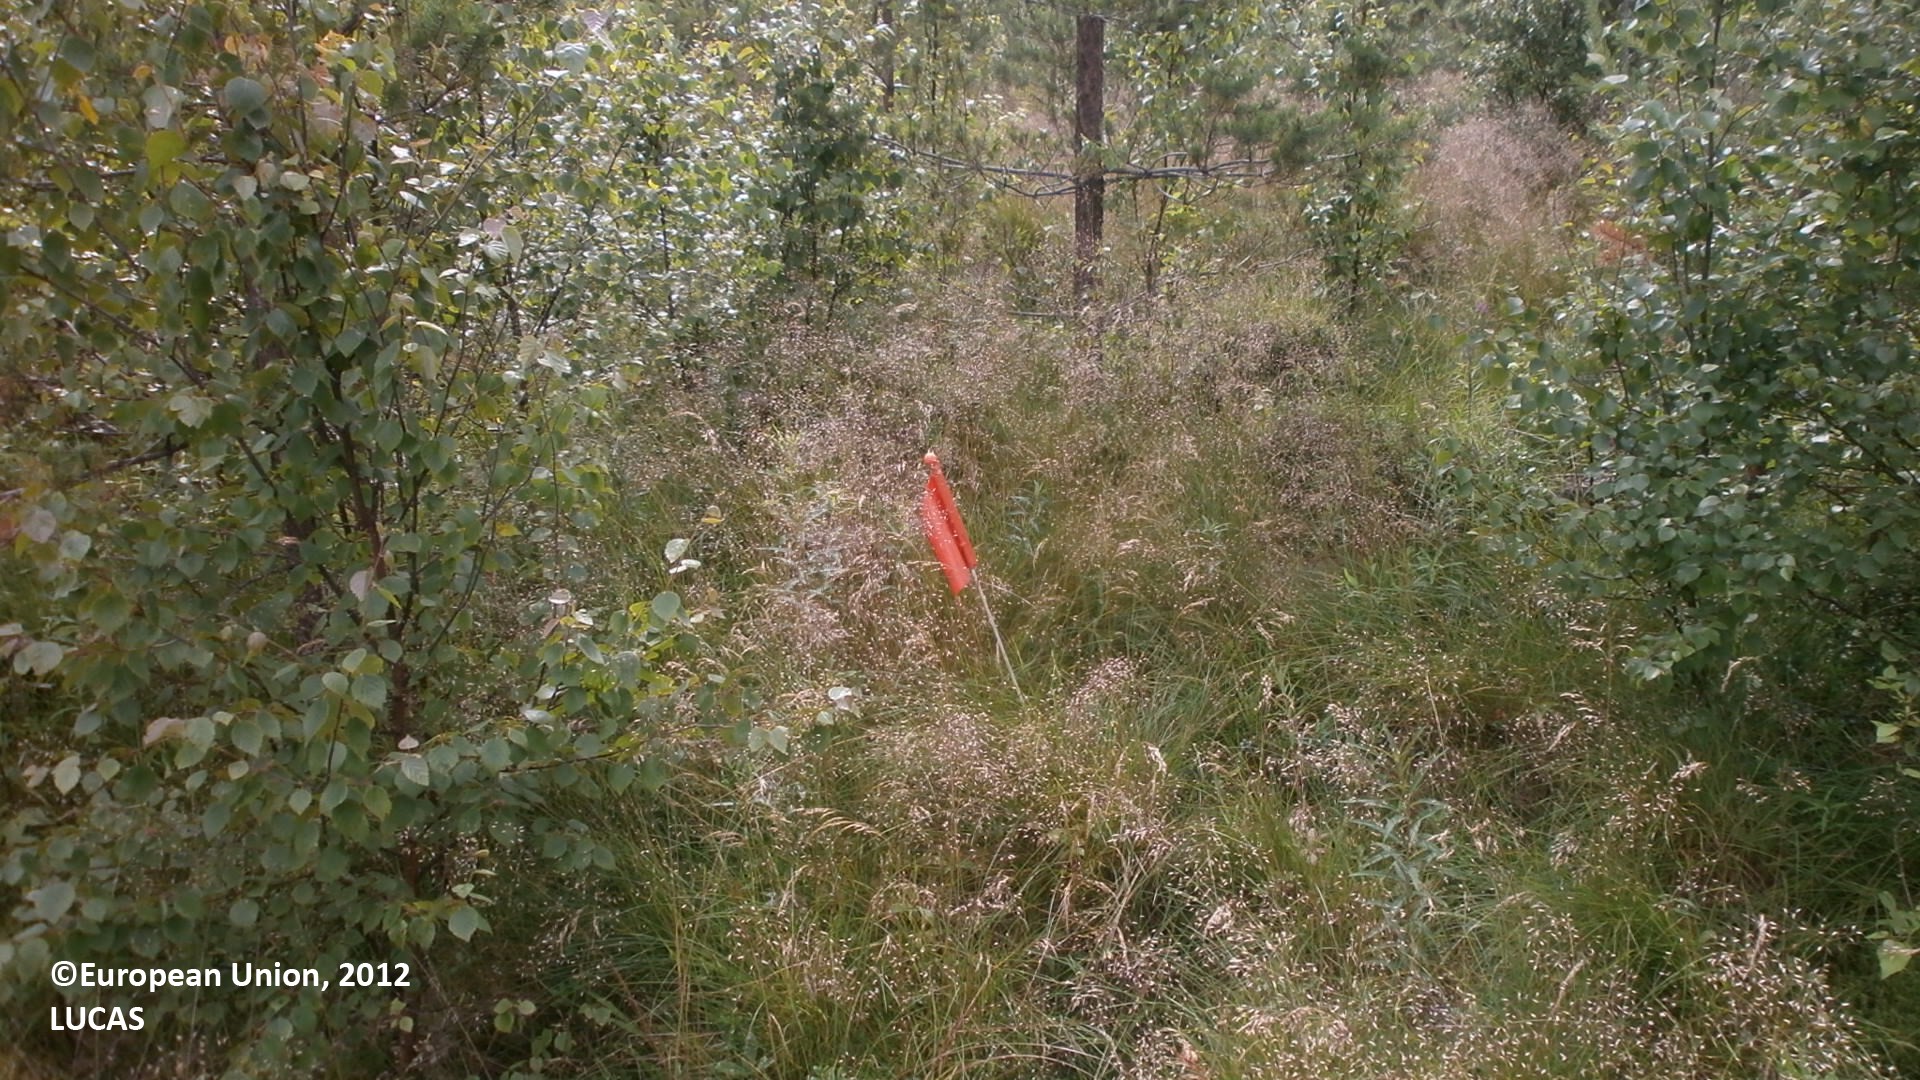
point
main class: Woodland
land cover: Pine dominated mixed woodland
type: boreal forest
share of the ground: 50 - 75 %
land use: Forestry
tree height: > 5 m
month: July
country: FI
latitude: 64.0134
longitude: 23.7873
